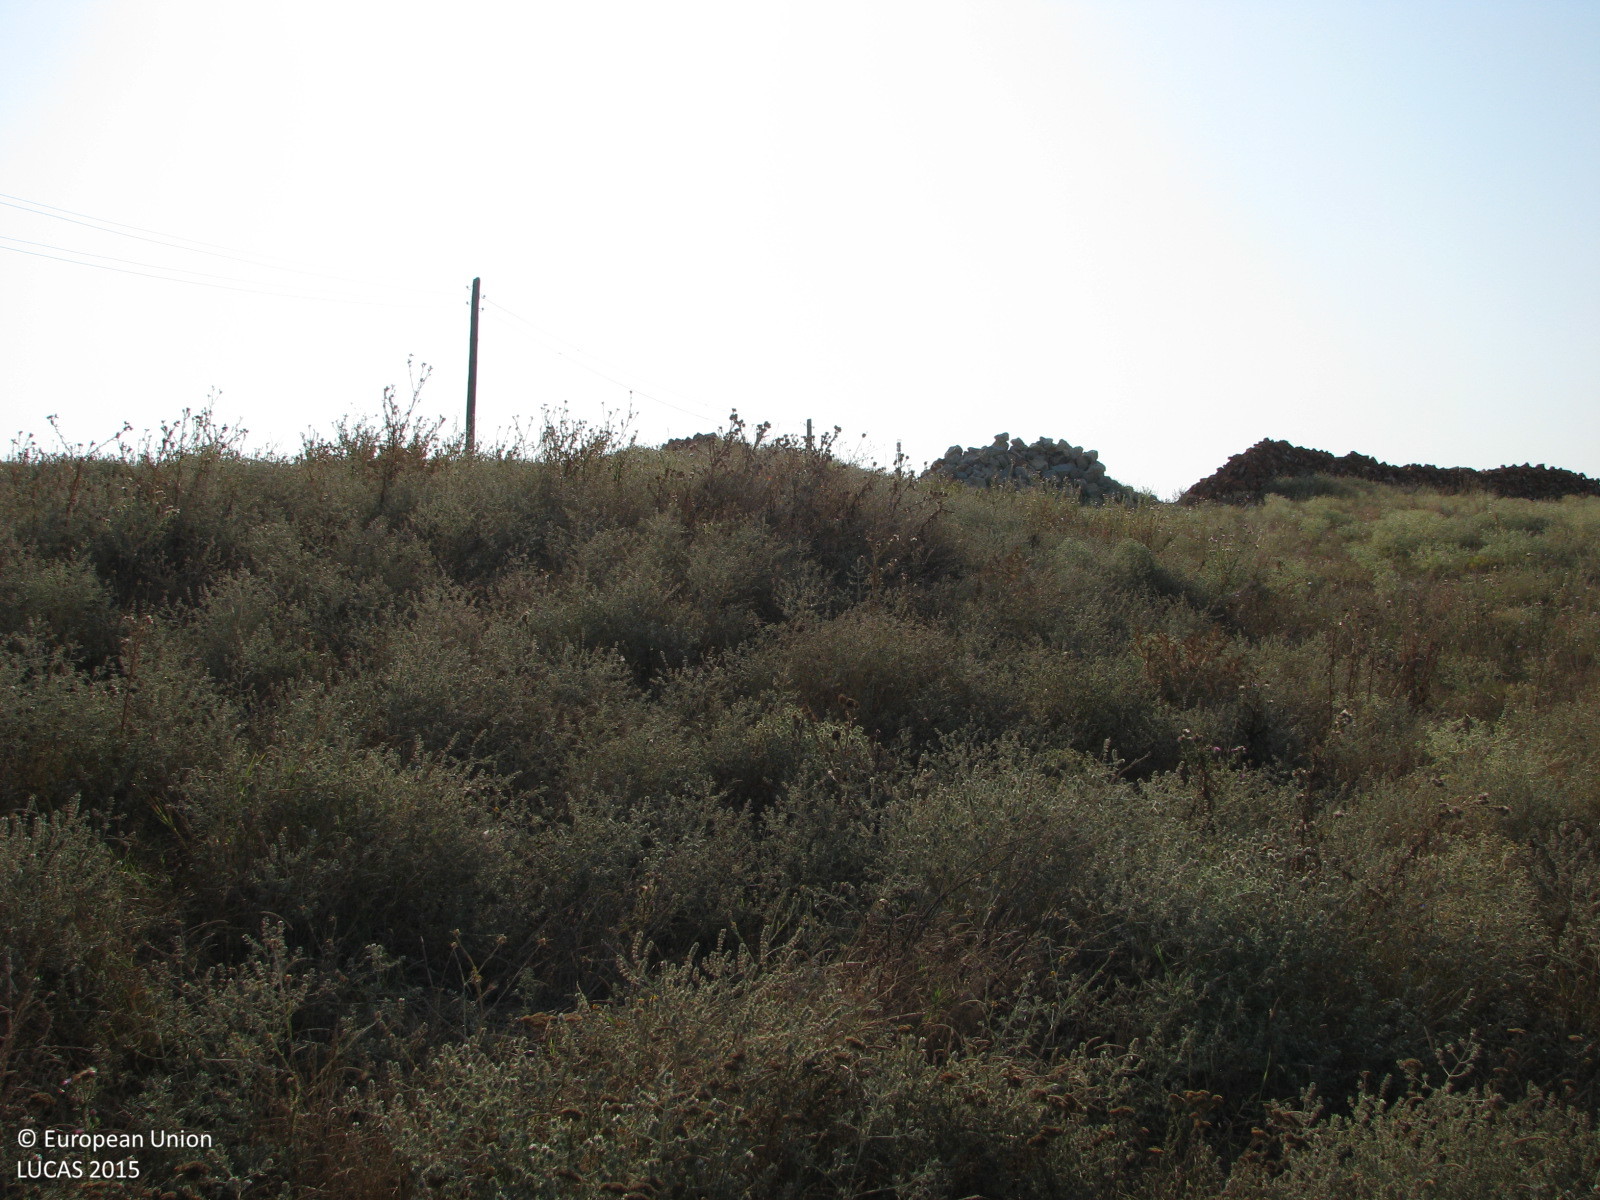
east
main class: Grassland
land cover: Spontaneously vegetated surfaces
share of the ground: > 75 %
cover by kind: herbaceous plants 100 %
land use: Agriculture (excluding fallow land and kitchen gardens)
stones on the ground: < 10 %
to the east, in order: Spontaneously vegetated surfaces; Tracks; Spontaneously vegetated surfaces; Electric lines; Spontaneously vegetated surfaces; Paved roads, cycling and walking lanes; Spontaneously vegetated surfaces; Tracks; Spontaneously vegetated surfaces; Sunflower
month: August
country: BG
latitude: 42.1703
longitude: 26.5150
